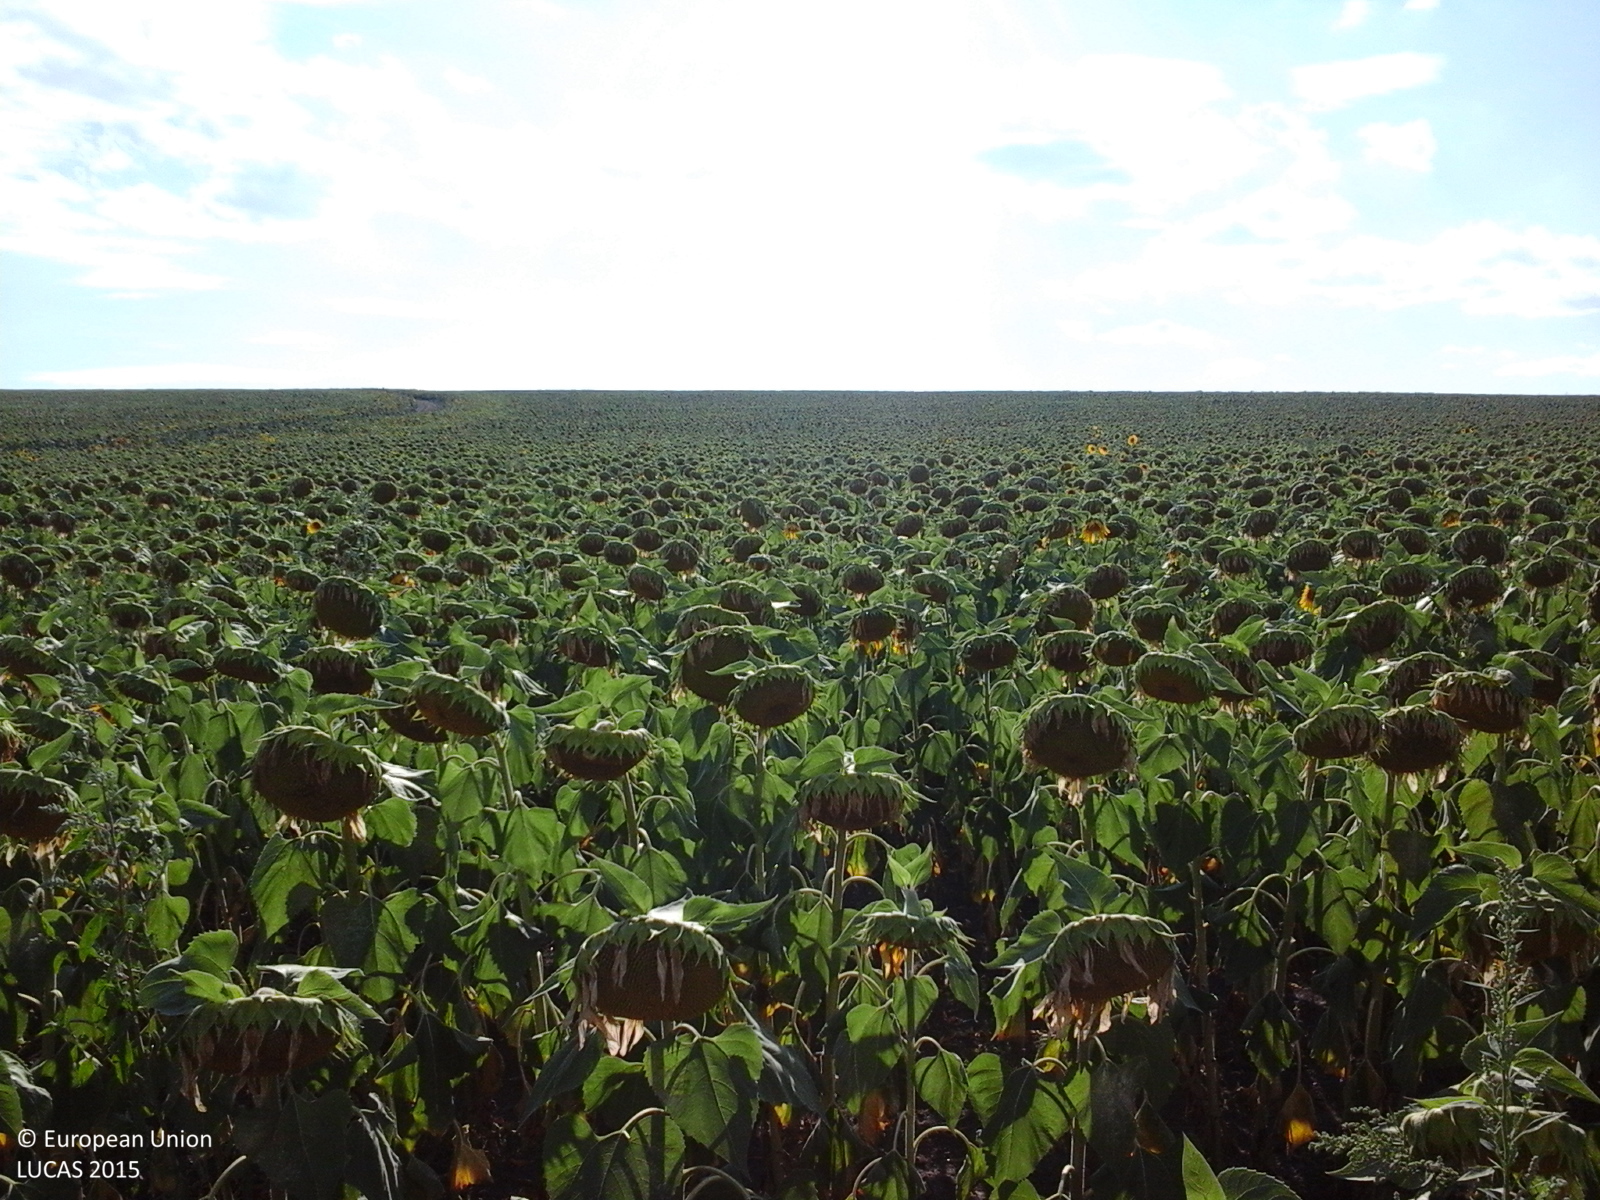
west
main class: Cropland
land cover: Sunflower
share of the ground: > 75 %
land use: Agriculture (excluding fallow land and kitchen gardens)
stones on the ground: < 10 %
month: July
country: RO
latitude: 46.2341
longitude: 27.5243
